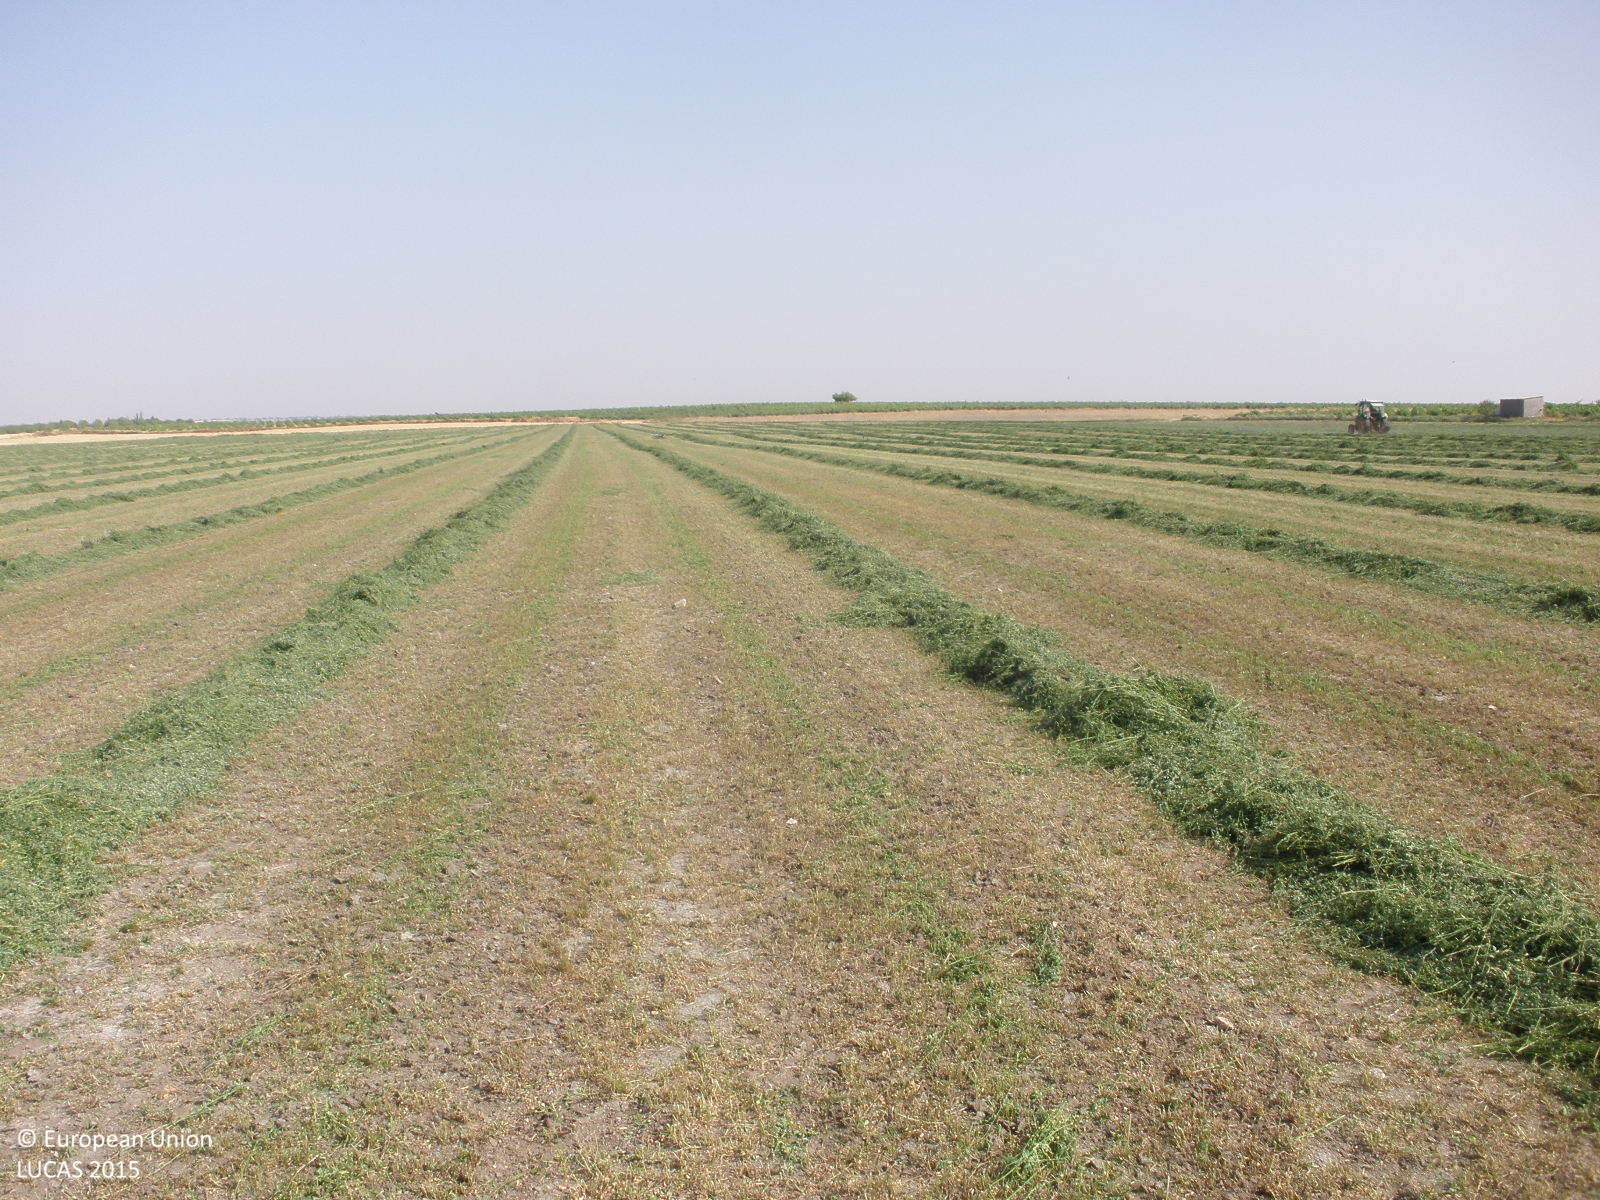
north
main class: Cropland
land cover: Lucerne
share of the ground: < 10 %
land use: Agriculture (excluding fallow land and kitchen gardens)
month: July
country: ES
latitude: 39.7650
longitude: -3.1312
